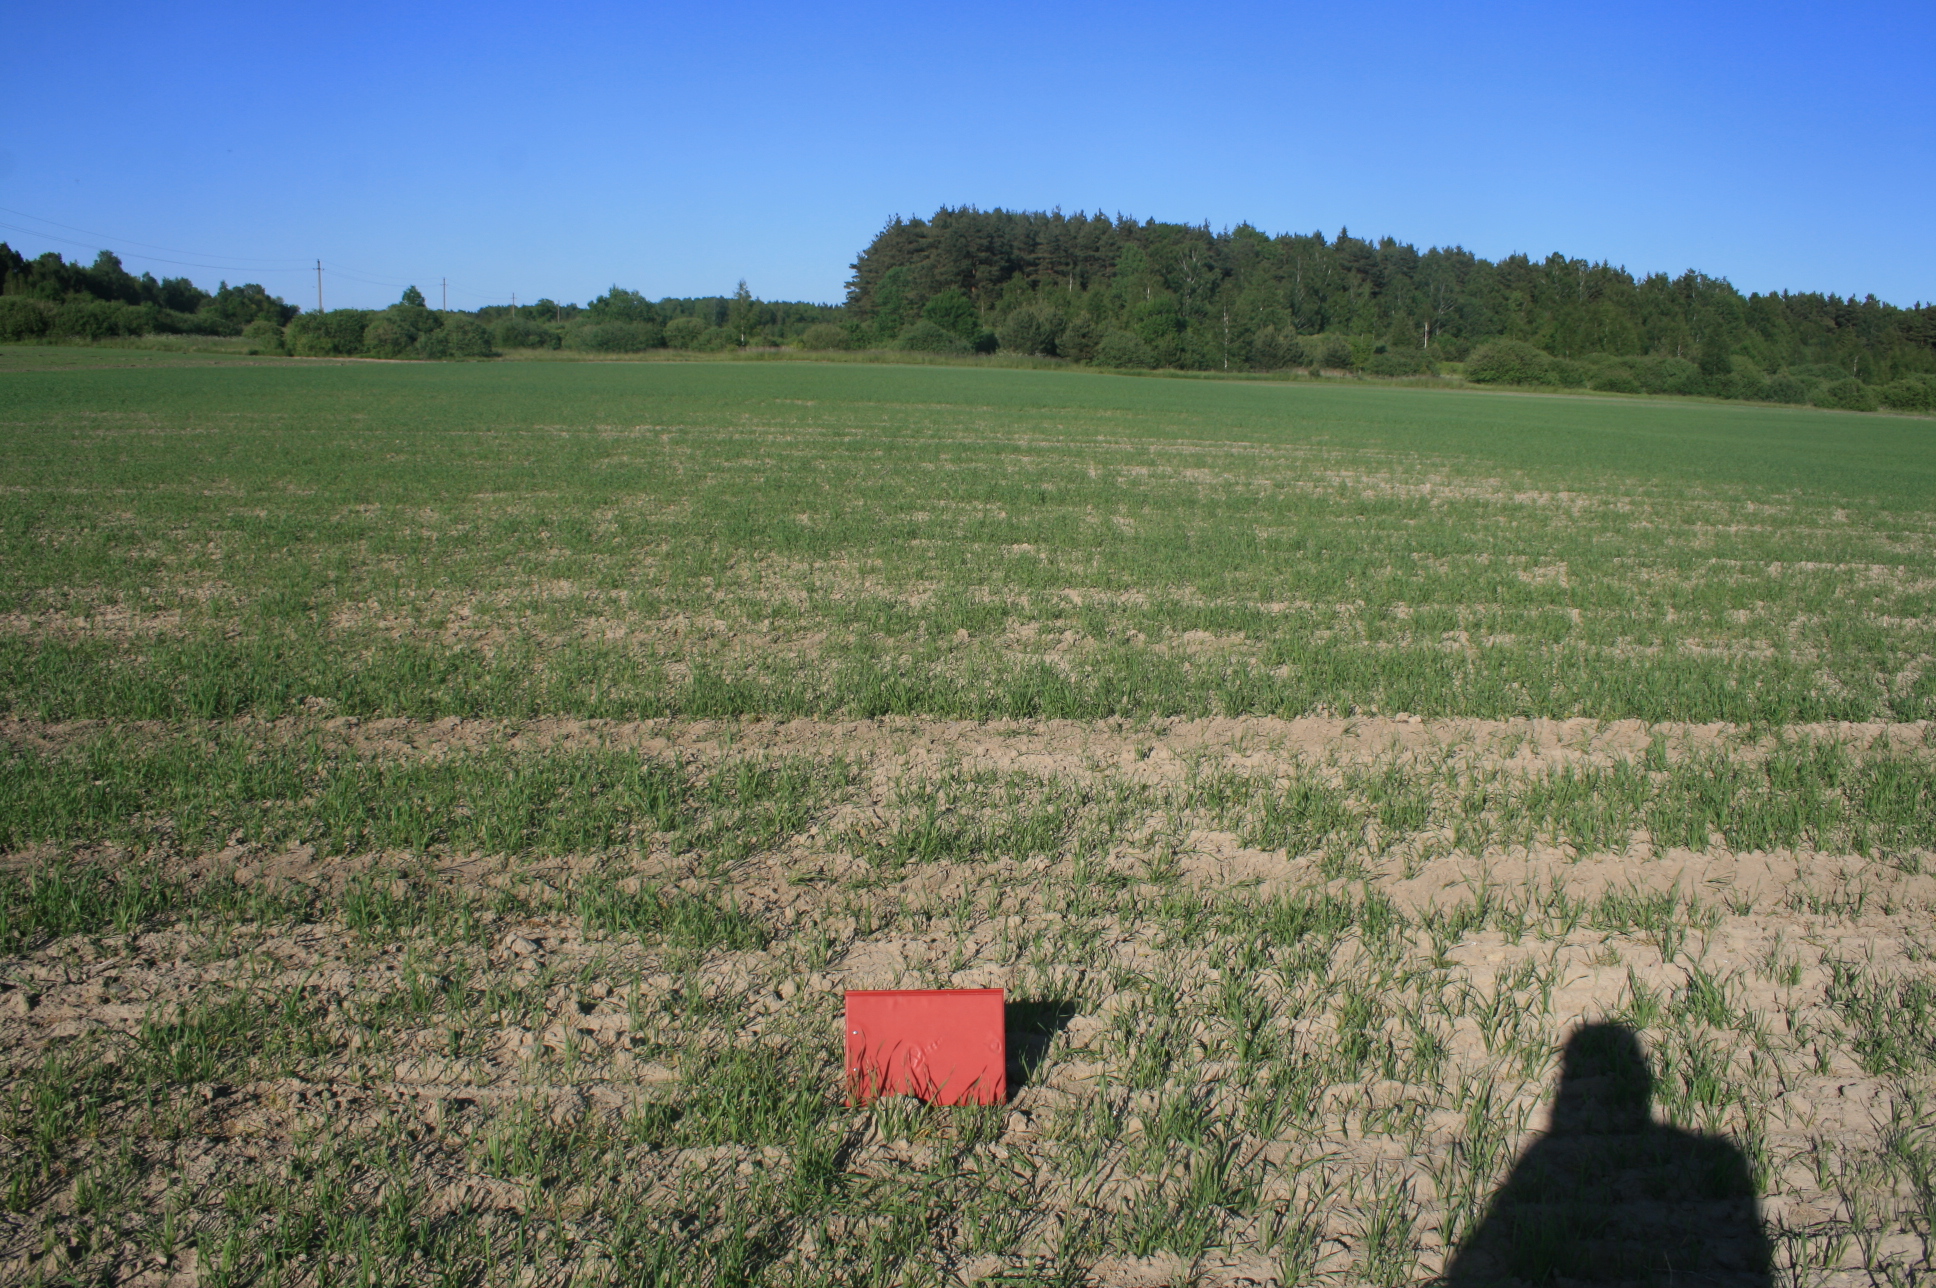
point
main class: Cropland
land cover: Barley
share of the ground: 50 - 75 %
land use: Agriculture (excluding fallow land and kitchen gardens)
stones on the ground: < 10 %
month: June
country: LT
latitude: 55.9210
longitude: 21.3235
